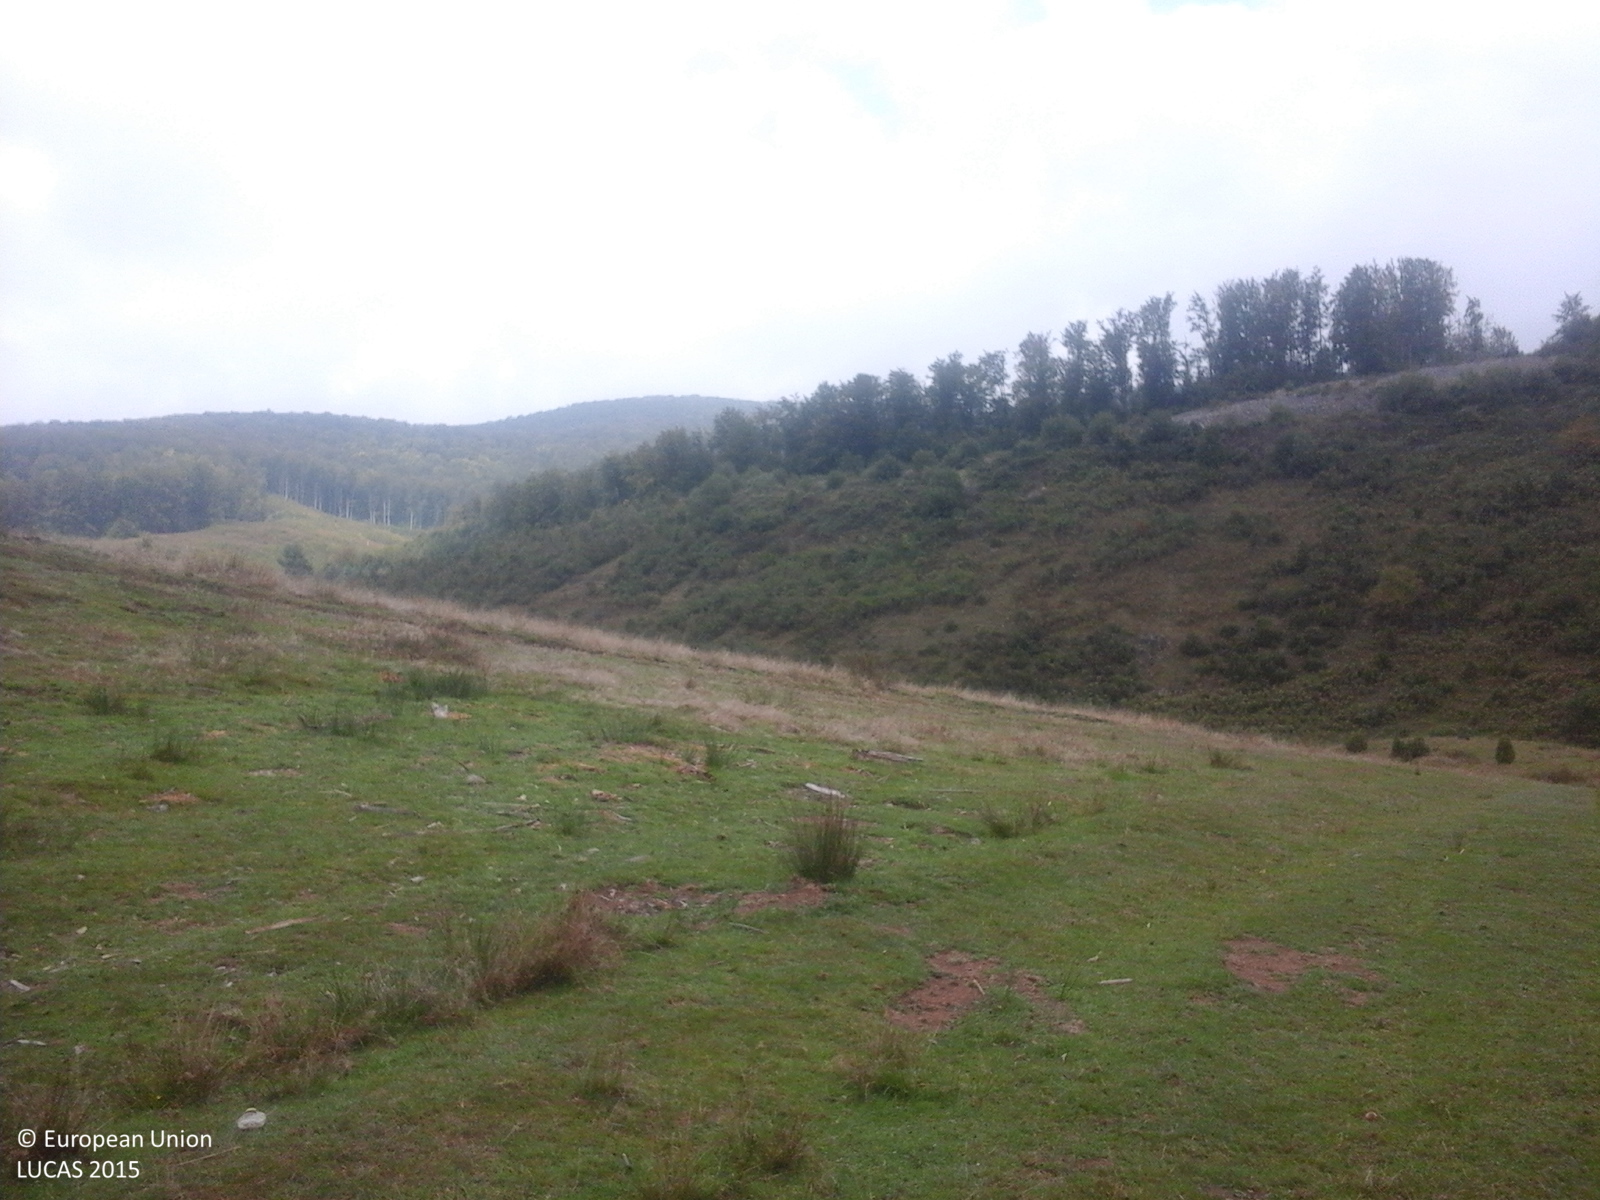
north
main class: Grassland
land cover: Grassland without tree/shrub cover
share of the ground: > 75 %
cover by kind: herbaceous plants 100 %
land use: Agriculture (excluding fallow land and kitchen gardens)
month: September
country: RO
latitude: 46.8563
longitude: 22.4740
